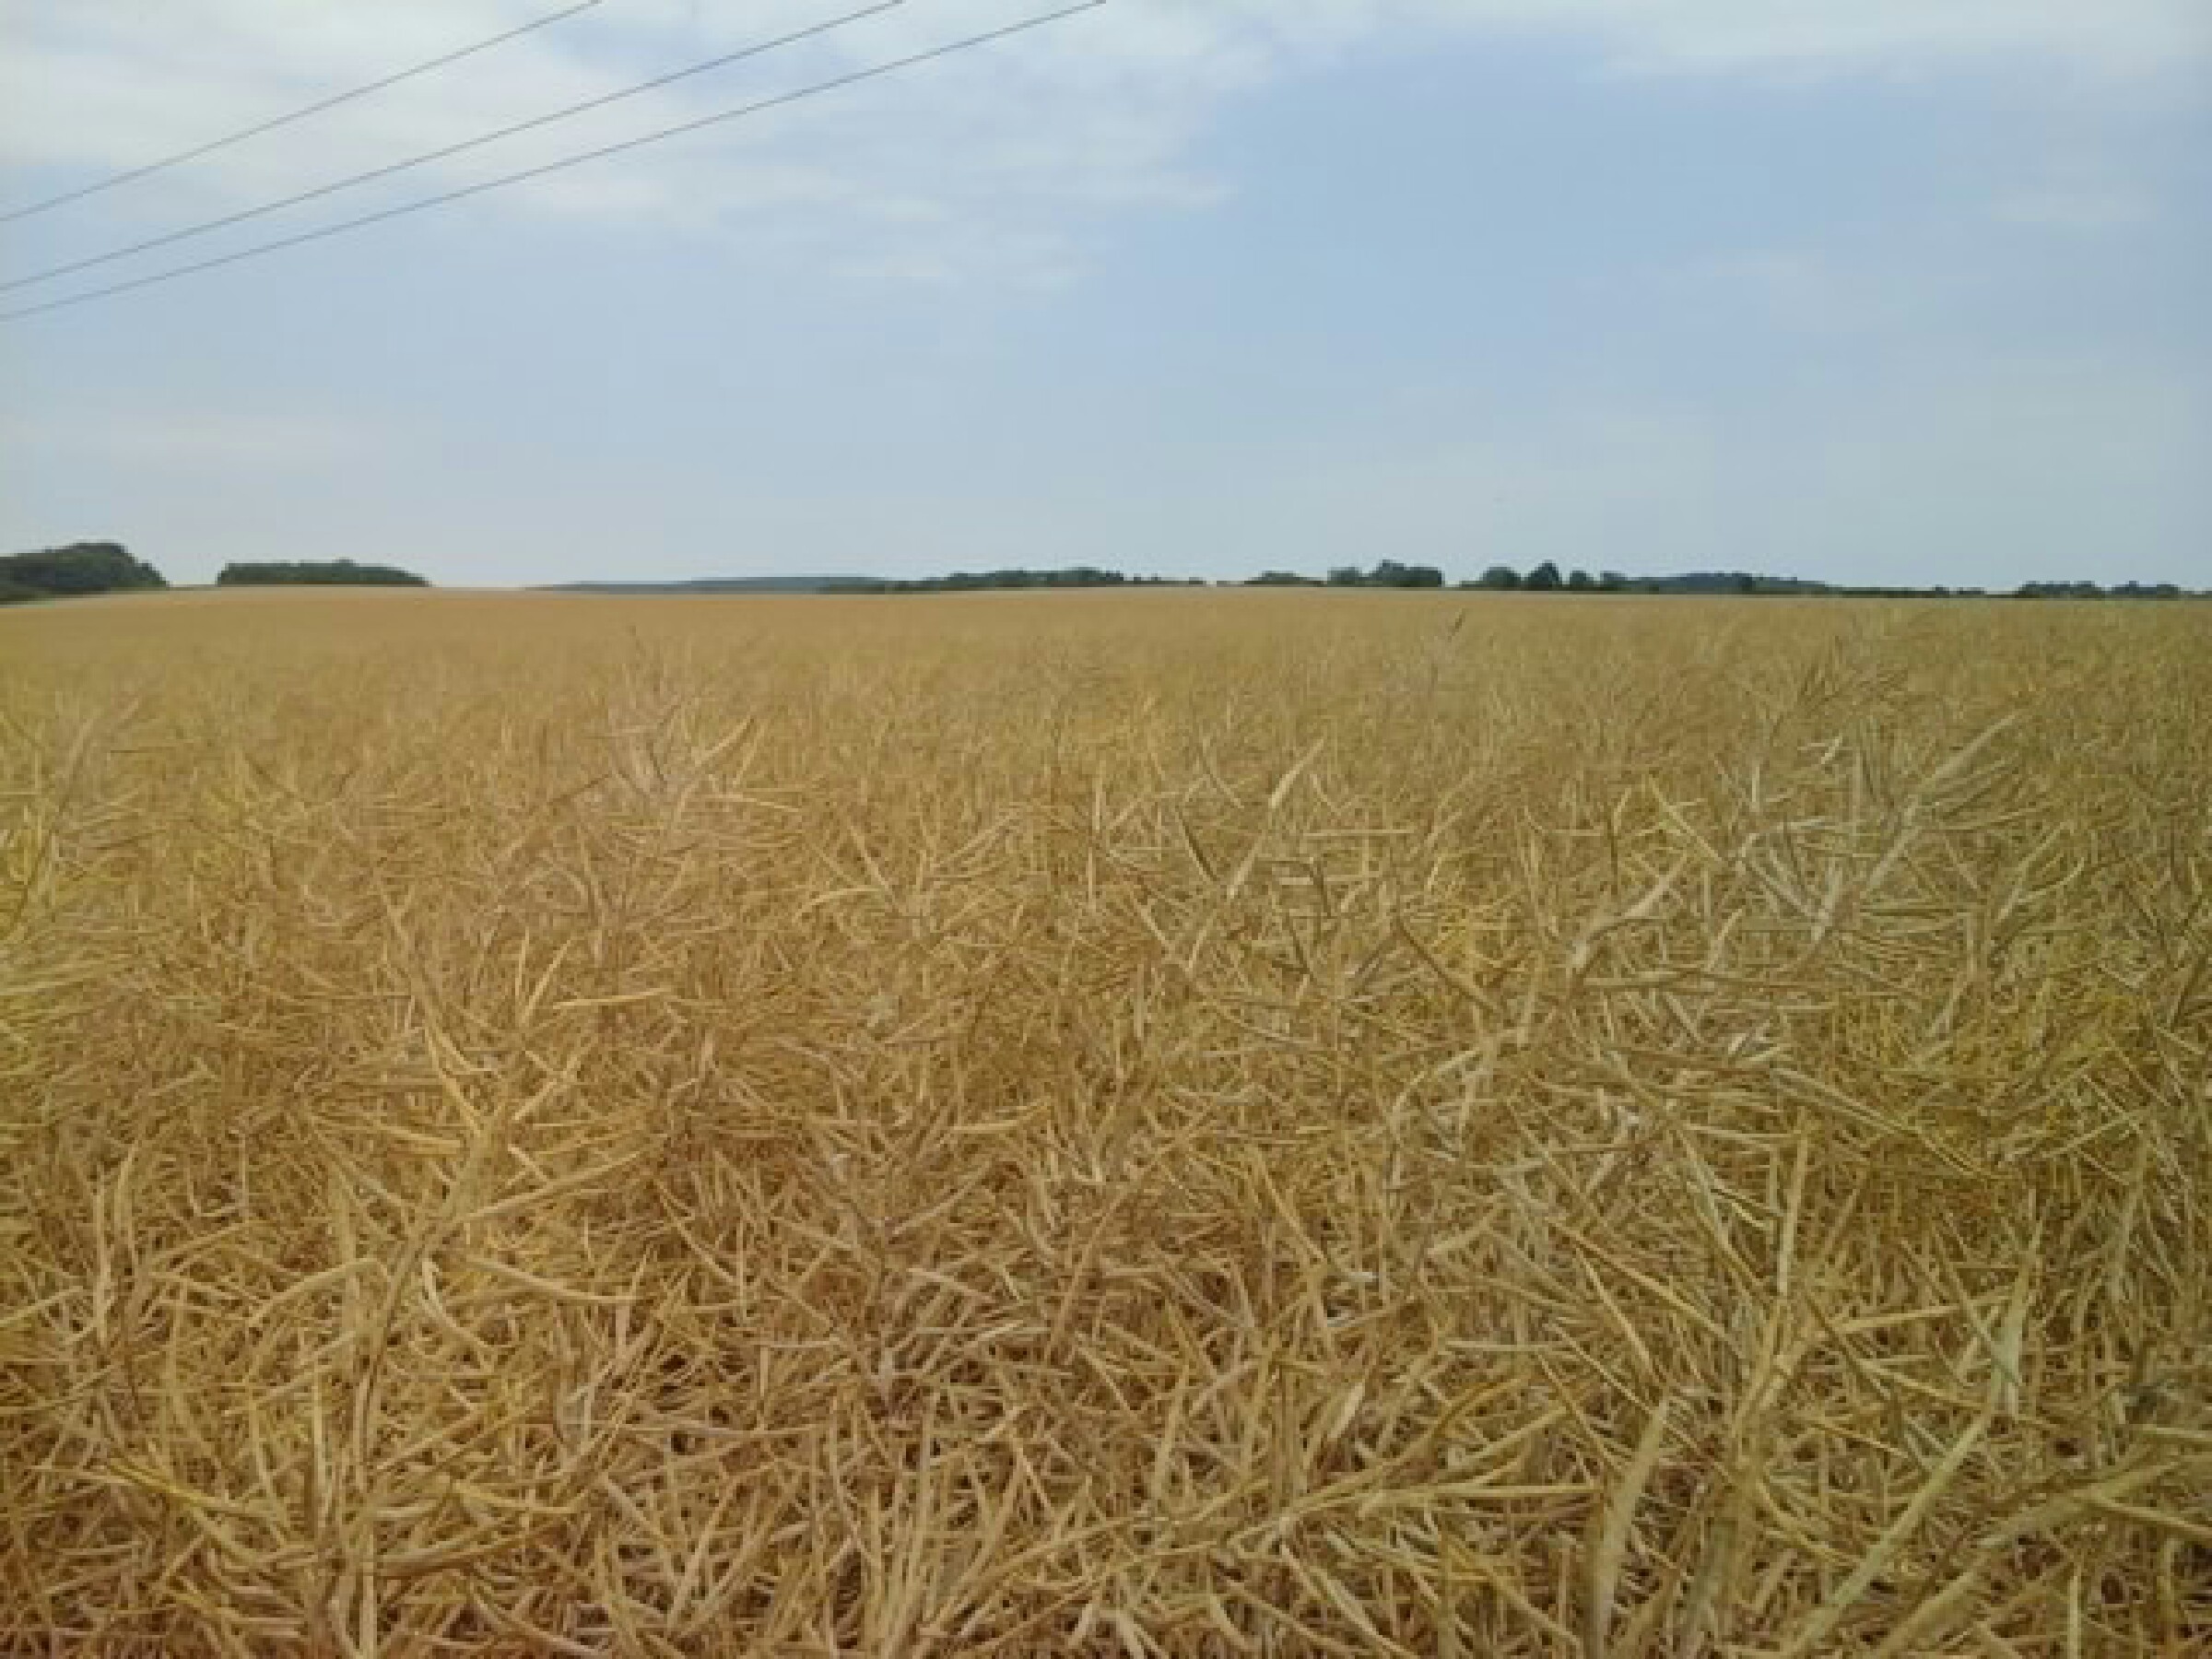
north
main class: Cropland
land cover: Rape and turnip rape
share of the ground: > 75 %
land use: Agriculture (excluding fallow land and kitchen gardens)
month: July
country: HU
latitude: 47.8493
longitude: 19.2821
